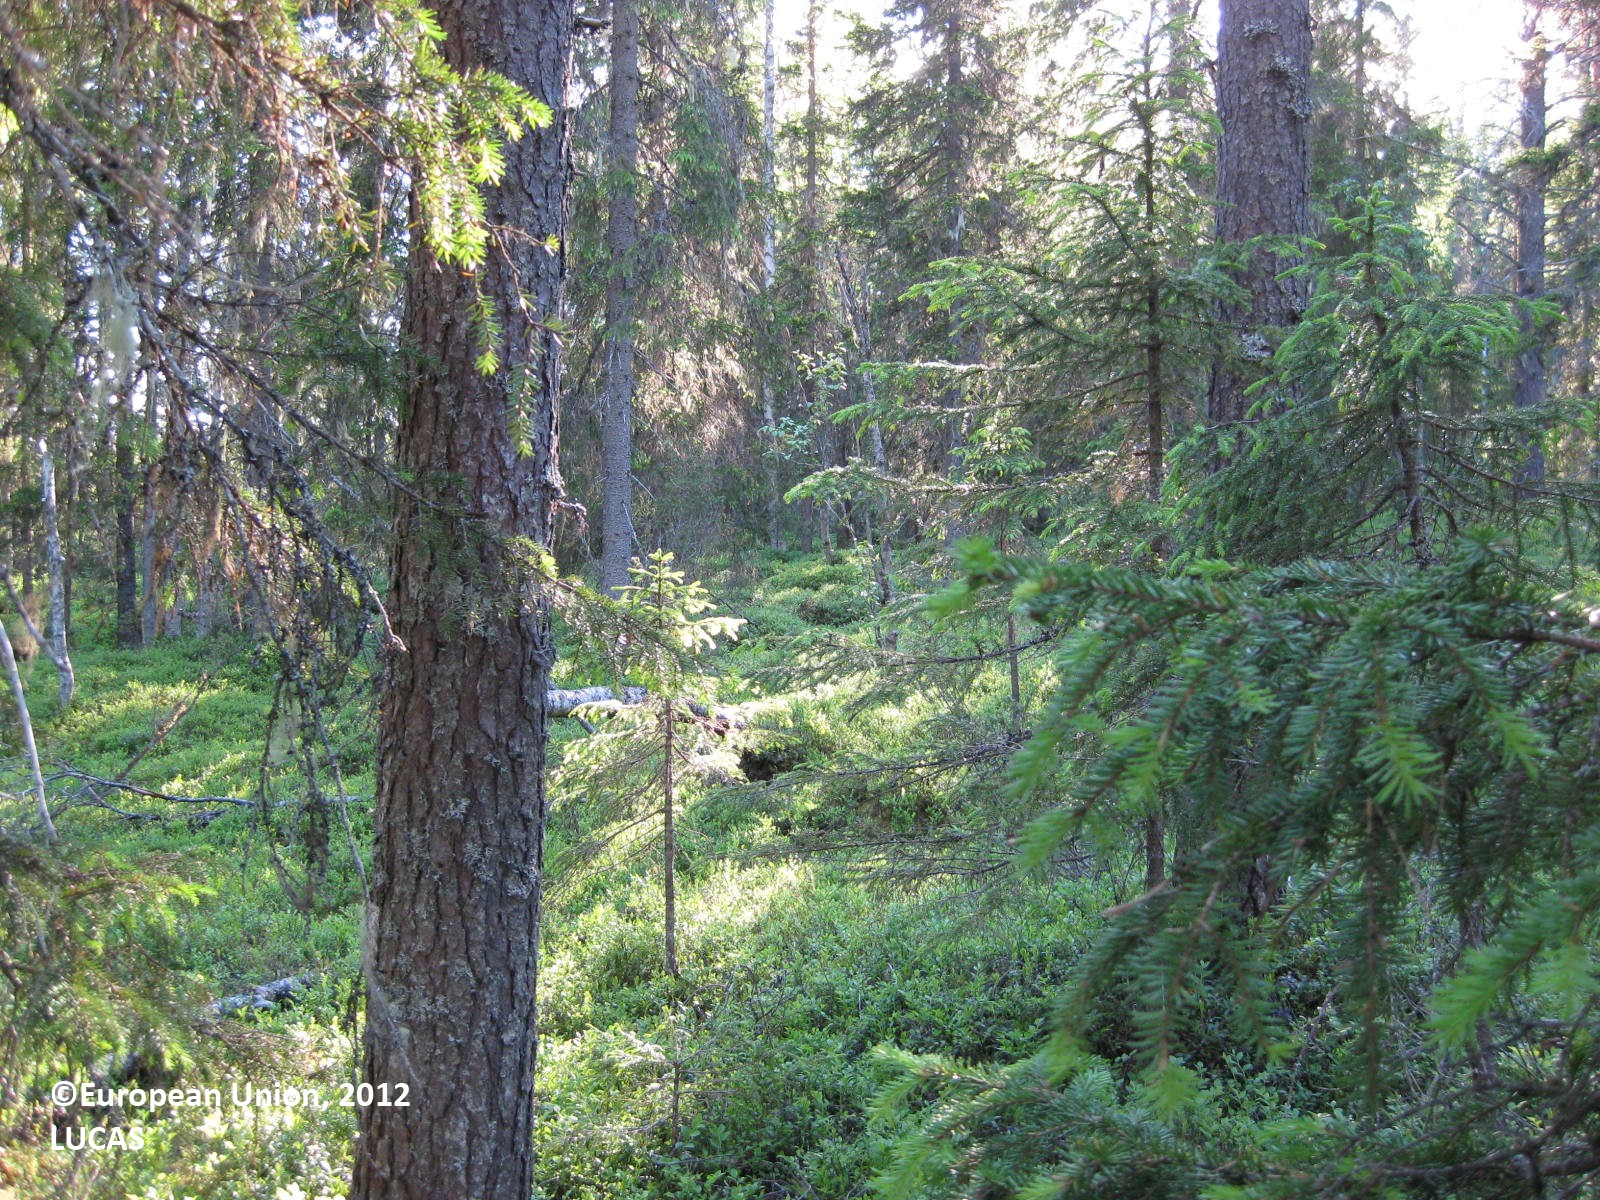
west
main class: Woodland
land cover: Spruce dominated coniferous woodland
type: boreal forest
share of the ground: > 75 %
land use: Forestry
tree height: > 5 m
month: June
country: FI
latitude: 65.2657
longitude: 28.2562
